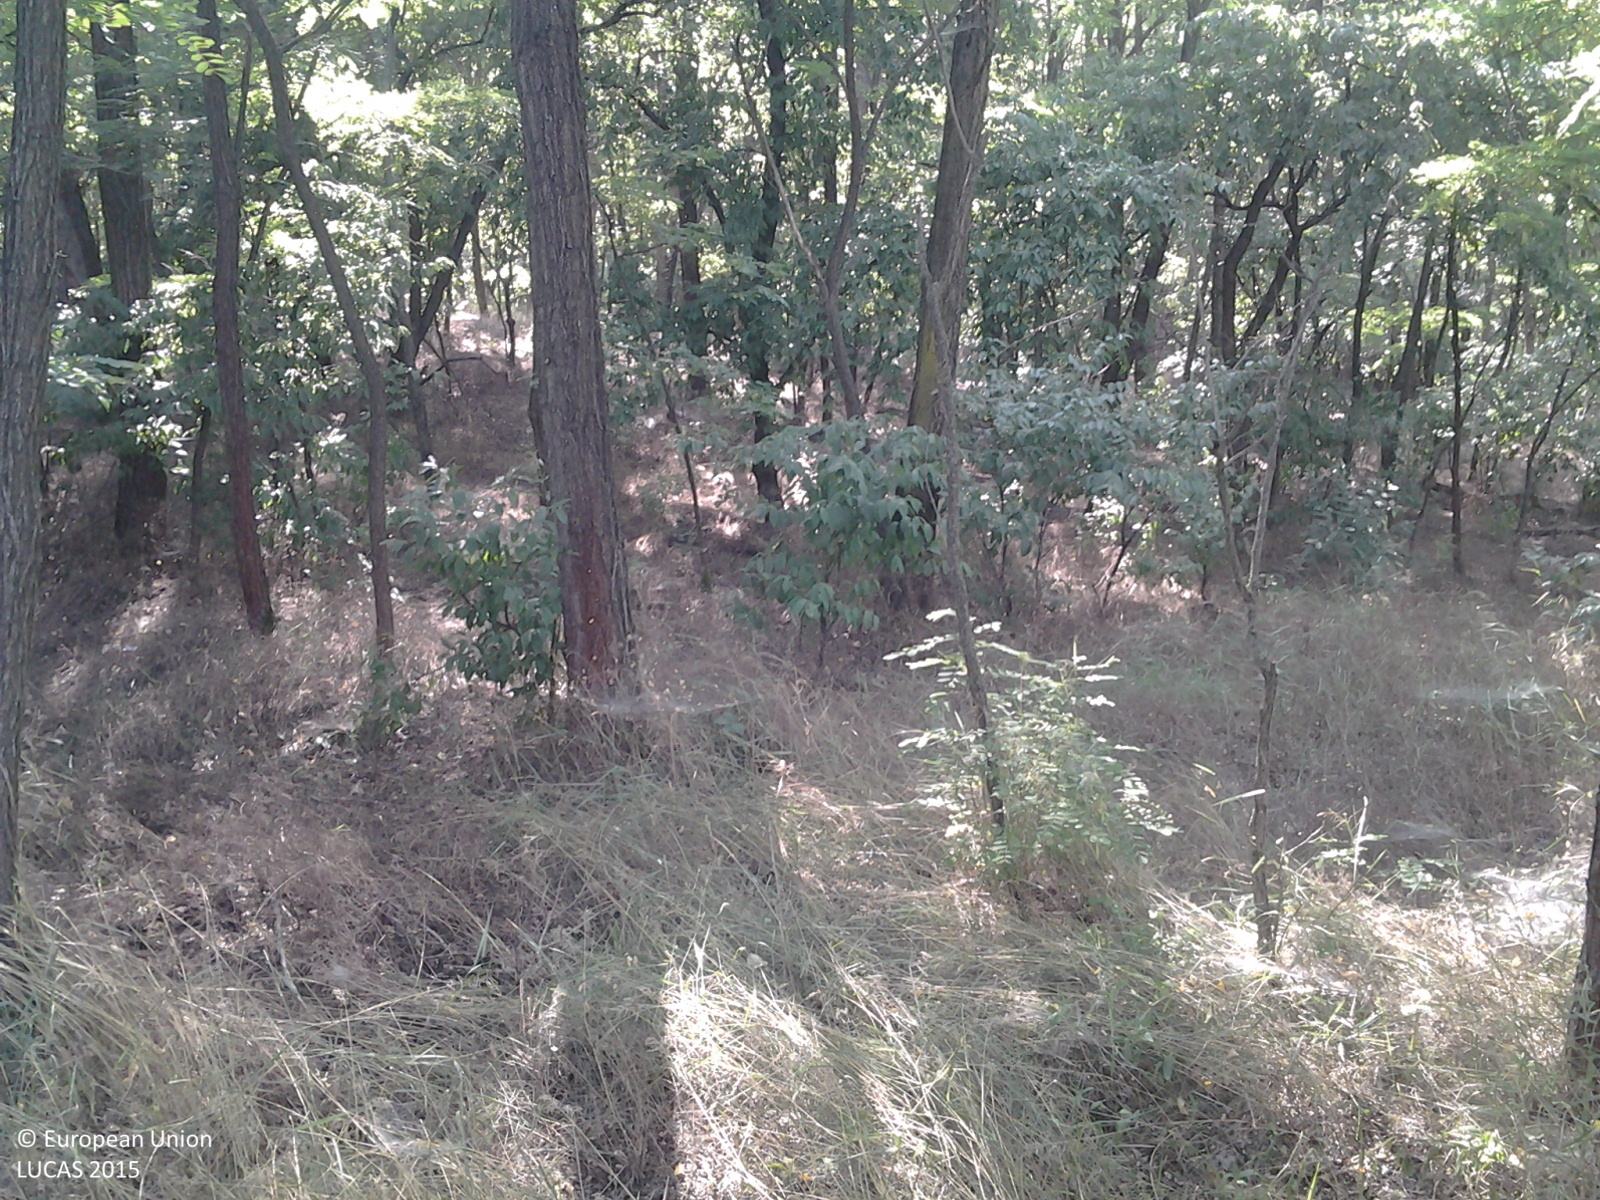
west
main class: Woodland
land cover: Broadleaved woodland
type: mesophytic deciduous forest
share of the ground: 50 - 75 %
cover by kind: broadleaved forest trees 70 %, herbaceous plants 30 %
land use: Forestry
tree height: > 5 m
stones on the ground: < 10 %
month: July
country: HU
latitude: 47.4346
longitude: 19.8758
